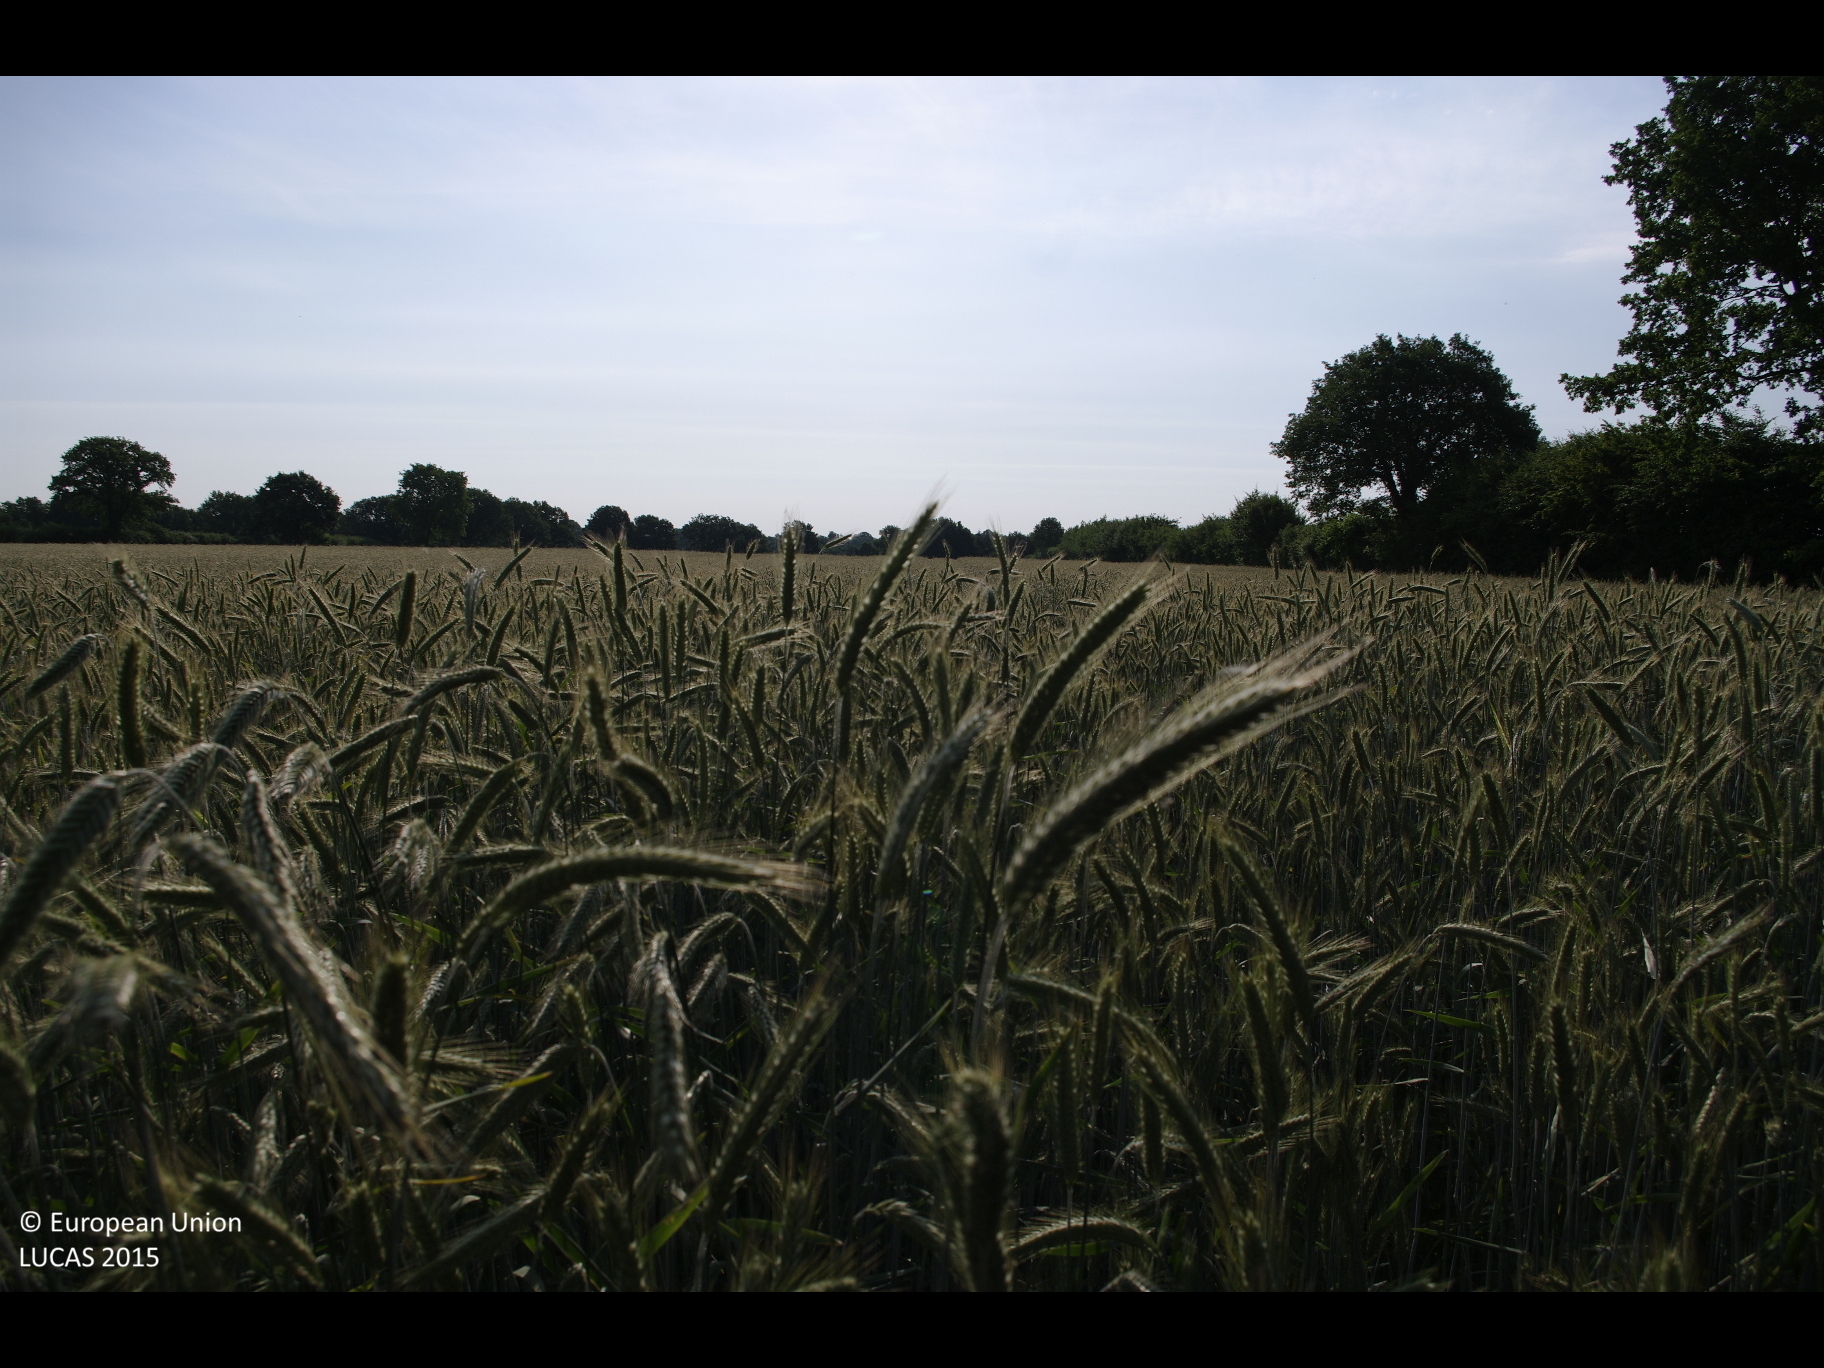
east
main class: Cropland
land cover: Rye
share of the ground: > 75 %
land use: Agriculture (excluding fallow land and kitchen gardens)
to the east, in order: Rye
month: July
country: DE
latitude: 53.7957
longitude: 10.6221
